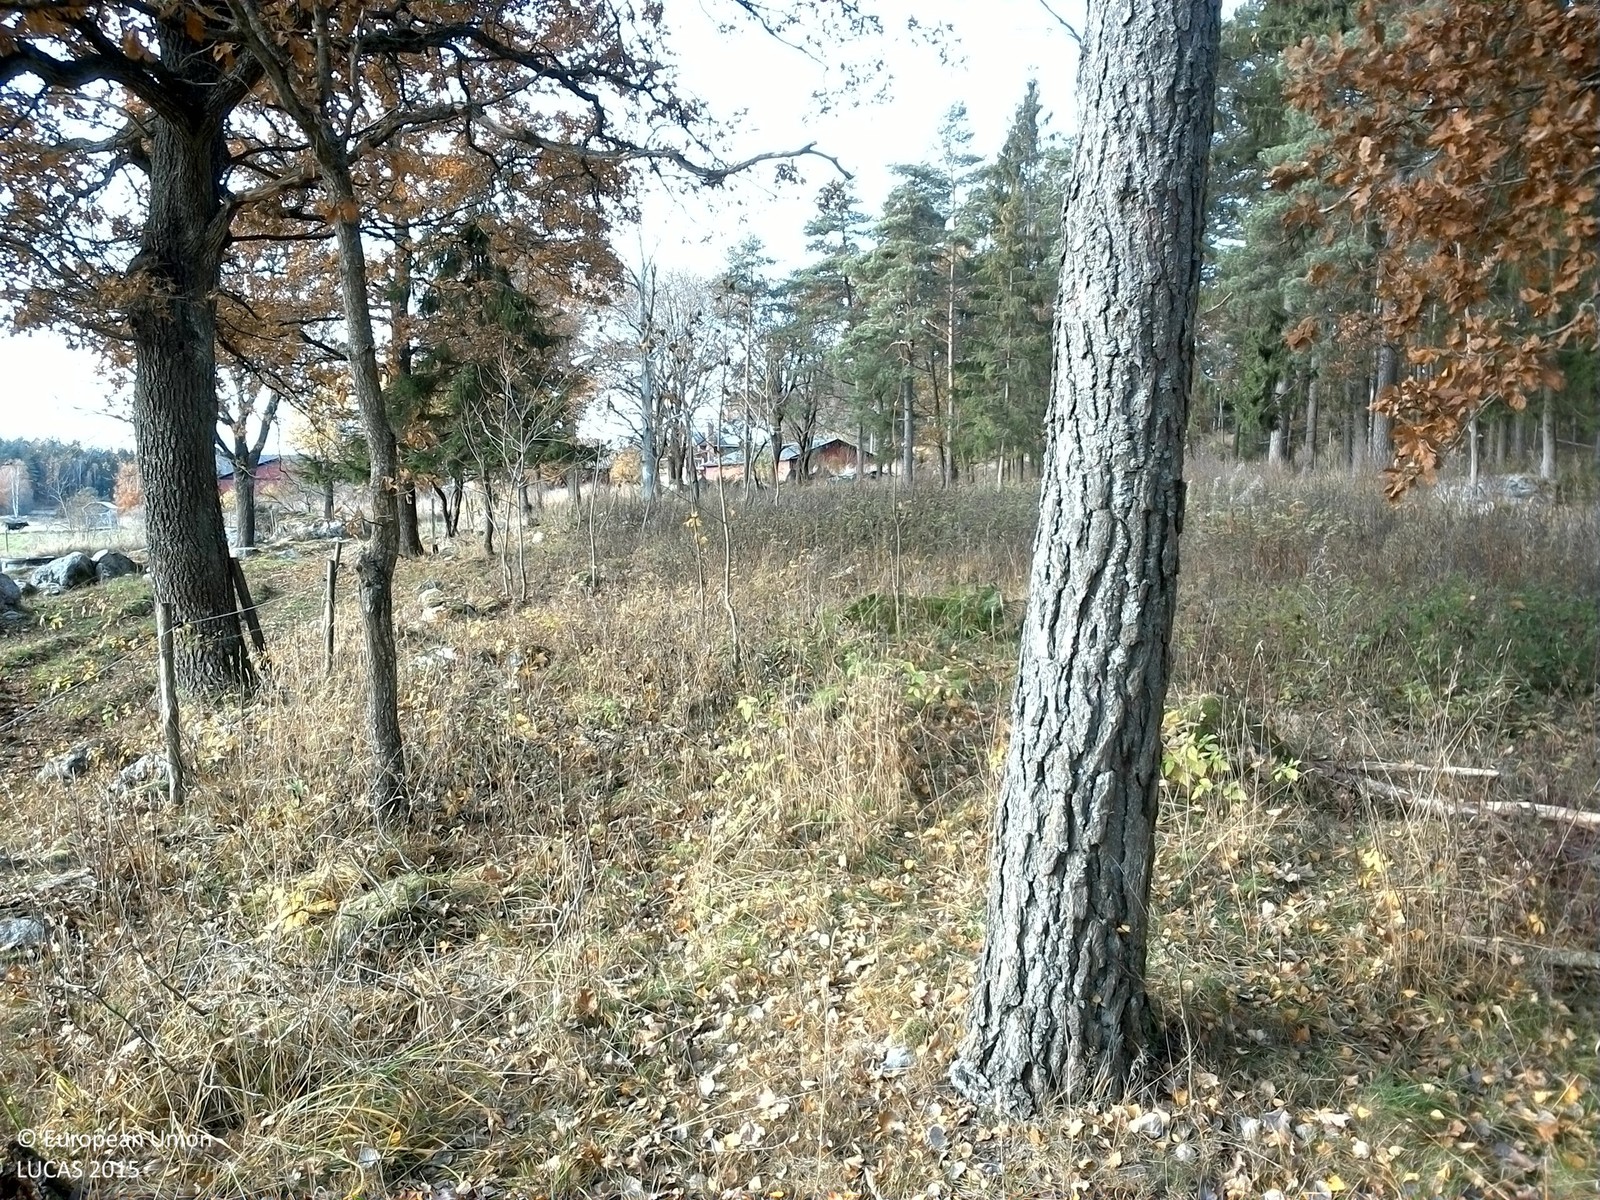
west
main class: Woodland
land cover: Pine dominated mixed woodland
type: boreal forest
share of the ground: 50 - 75 %
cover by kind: coniferous forest trees 25 %, broadleaved forest trees 25 %, herbaceous plants 25 %, shrubs 15 %, consolidated bare surface 10 %
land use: Forestry
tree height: > 5 m
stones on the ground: < 10 %
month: October
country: SE
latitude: 59.3105
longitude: 16.8272
